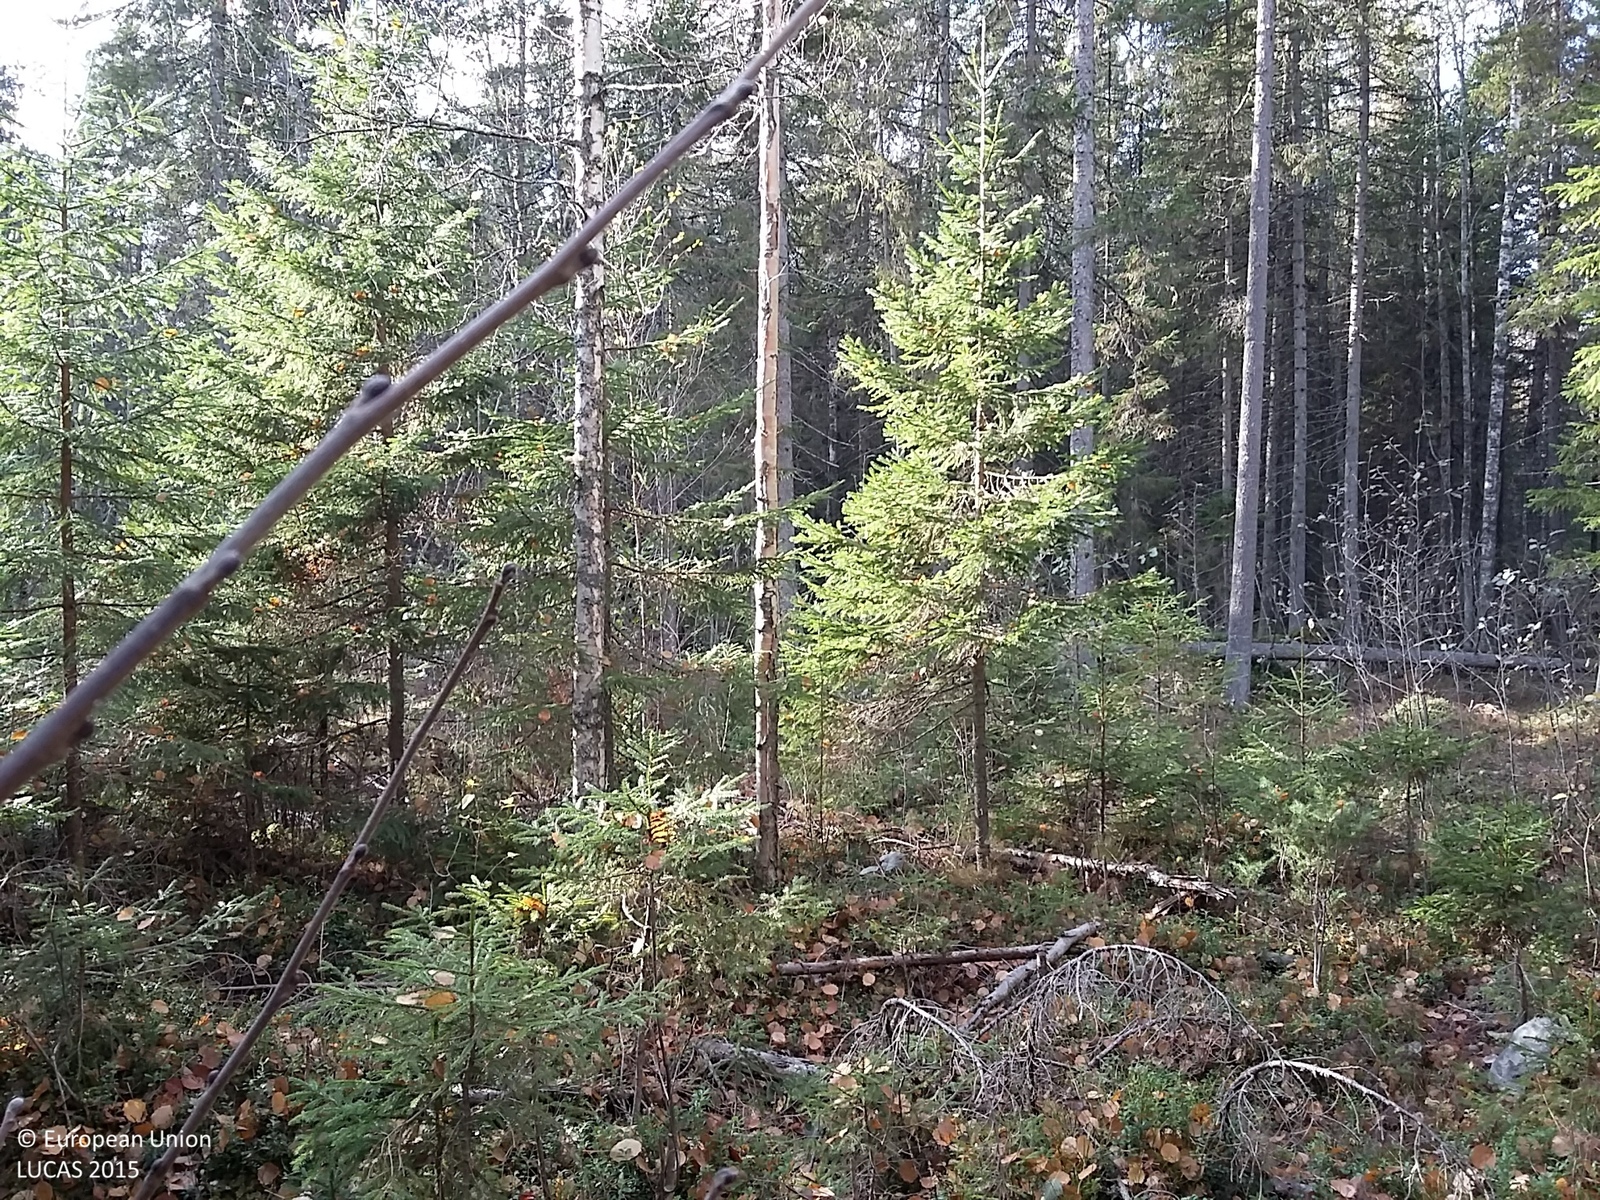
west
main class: Woodland
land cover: Spruce dominated mixed woodland
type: boreal forest
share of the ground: > 75 %
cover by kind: coniferous forest trees 45 %, broadleaved forest trees 40 %, herbaceous plants 10 %, lichens and mosses 5 %
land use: Forestry
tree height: > 5 m
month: October
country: FI
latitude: 62.7987
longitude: 26.0245
